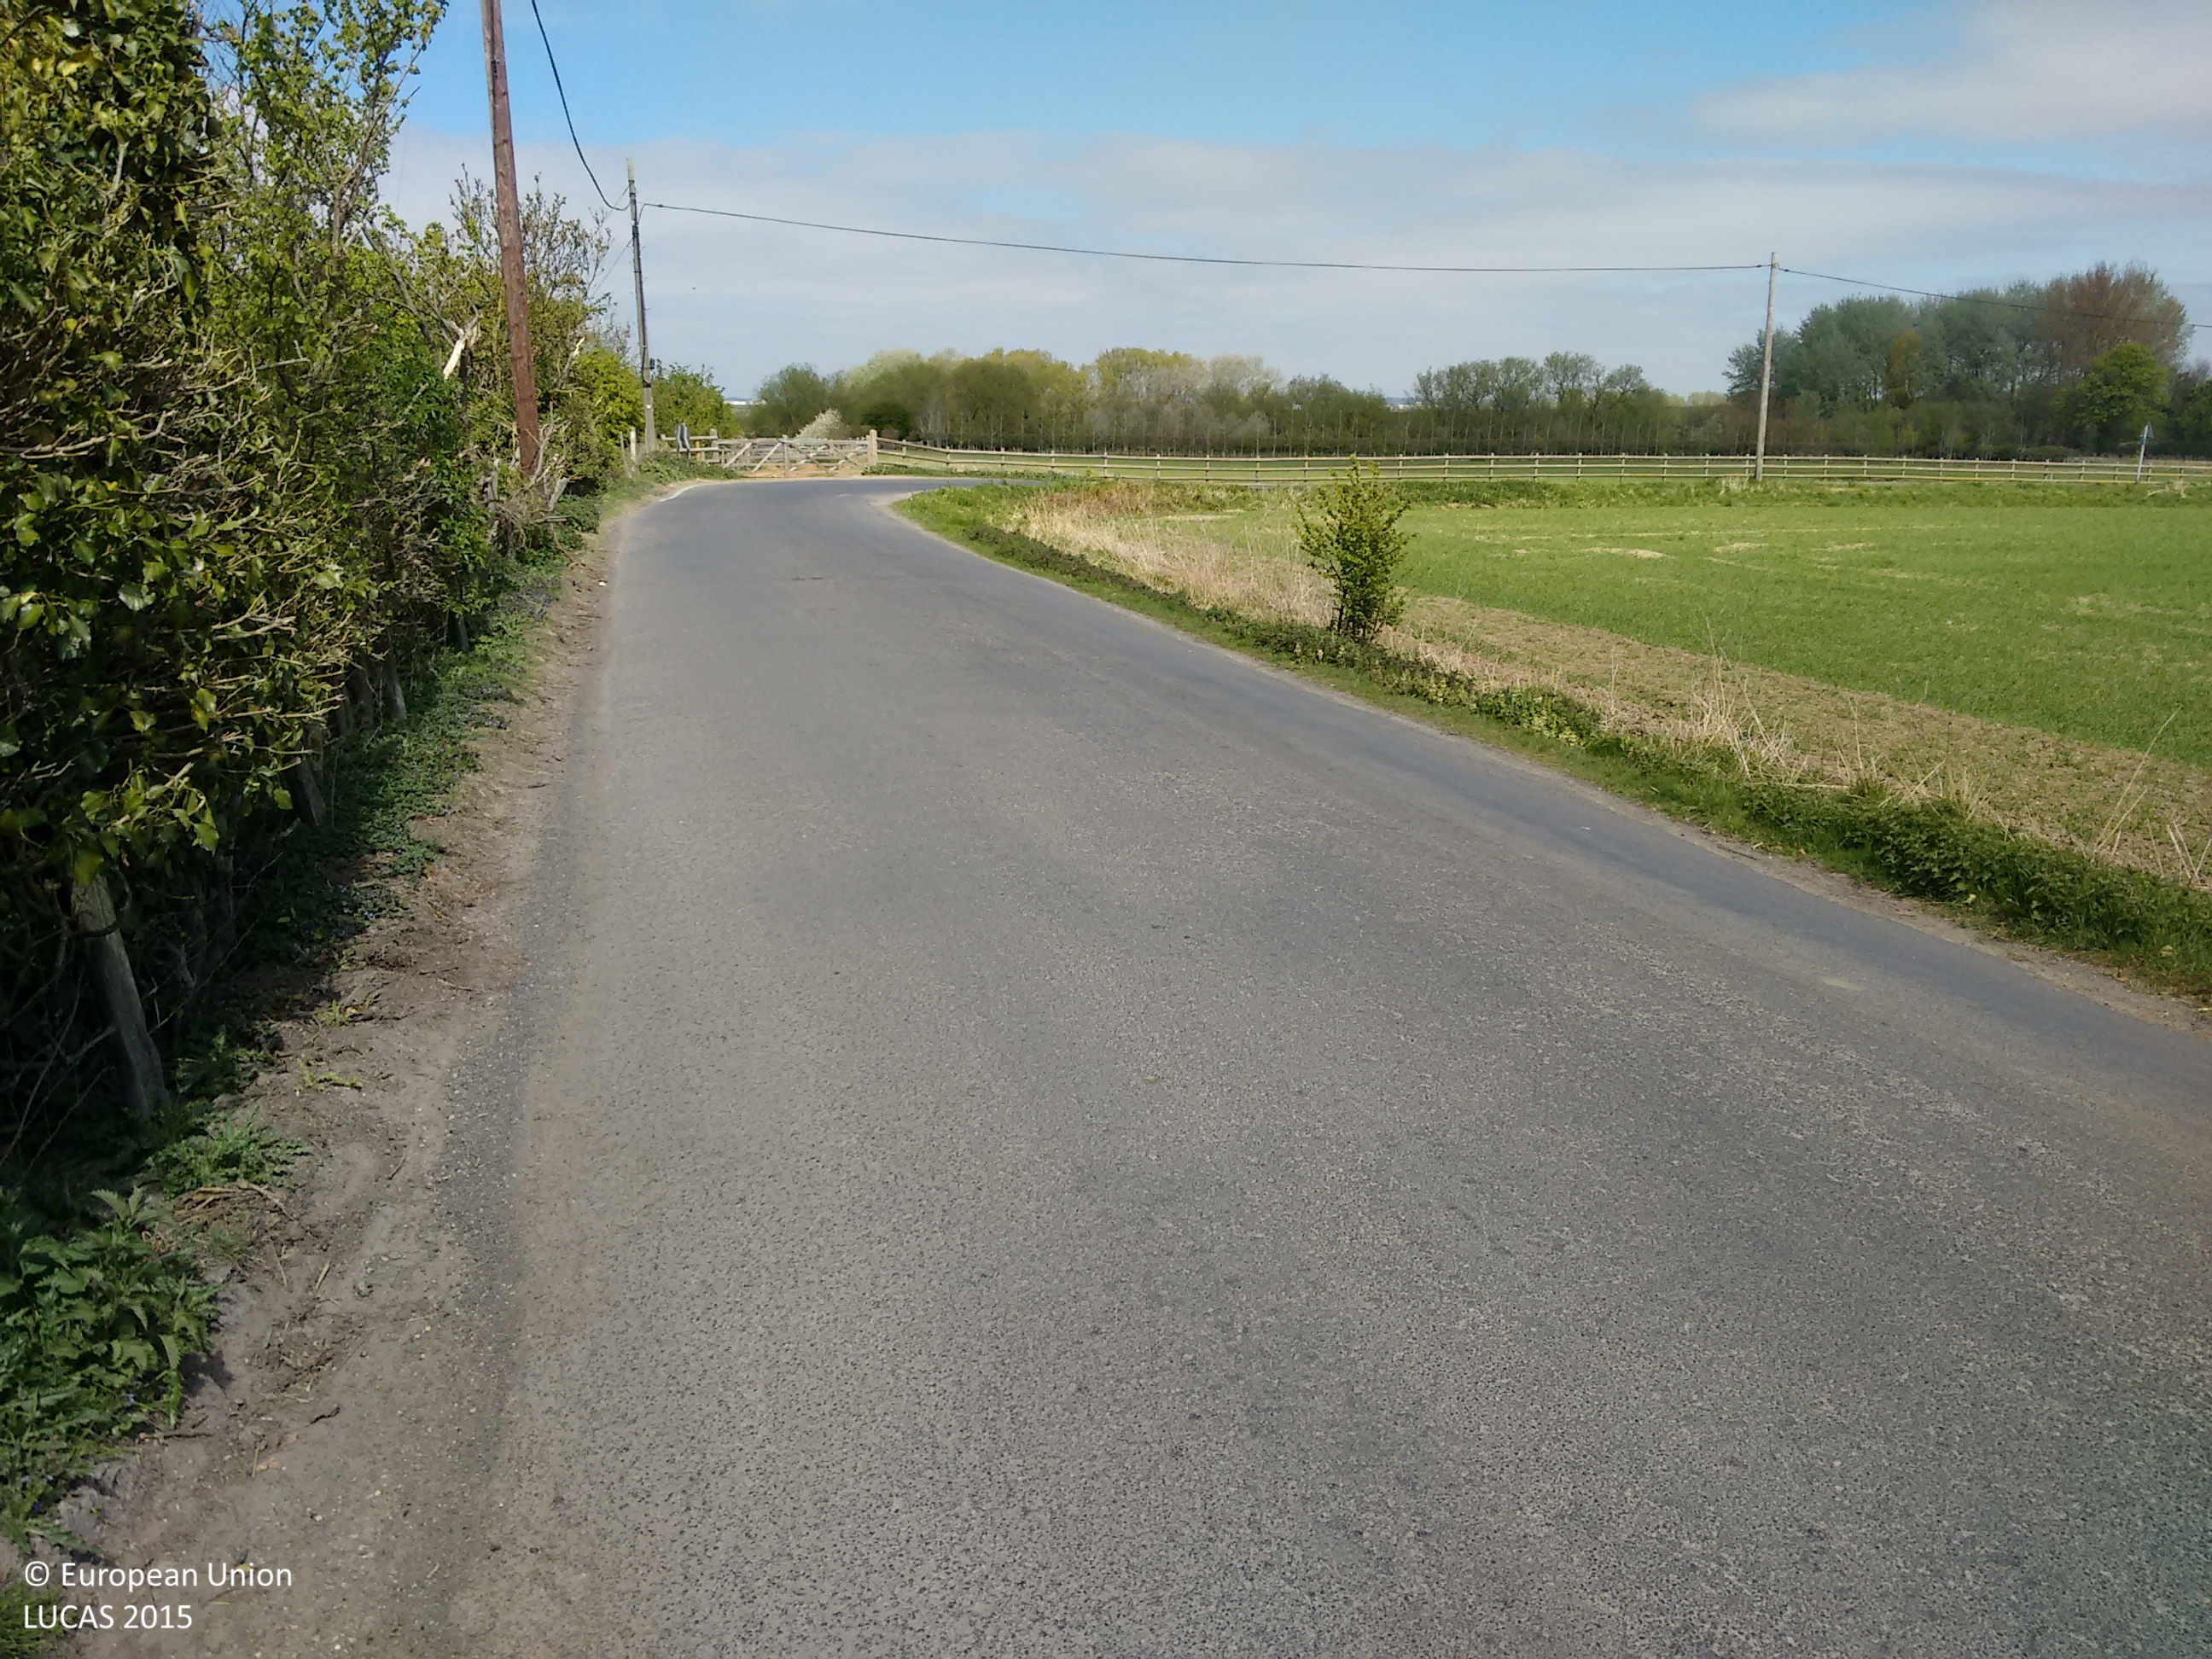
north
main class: Grassland
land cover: Grassland without tree/shrub cover
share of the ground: > 75 %
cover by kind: herbaceous plants 80 %, unconsolidated bare surface 20 %
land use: Agriculture (excluding fallow land and kitchen gardens)
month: April
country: GB
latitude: 51.4540
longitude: 0.5174
